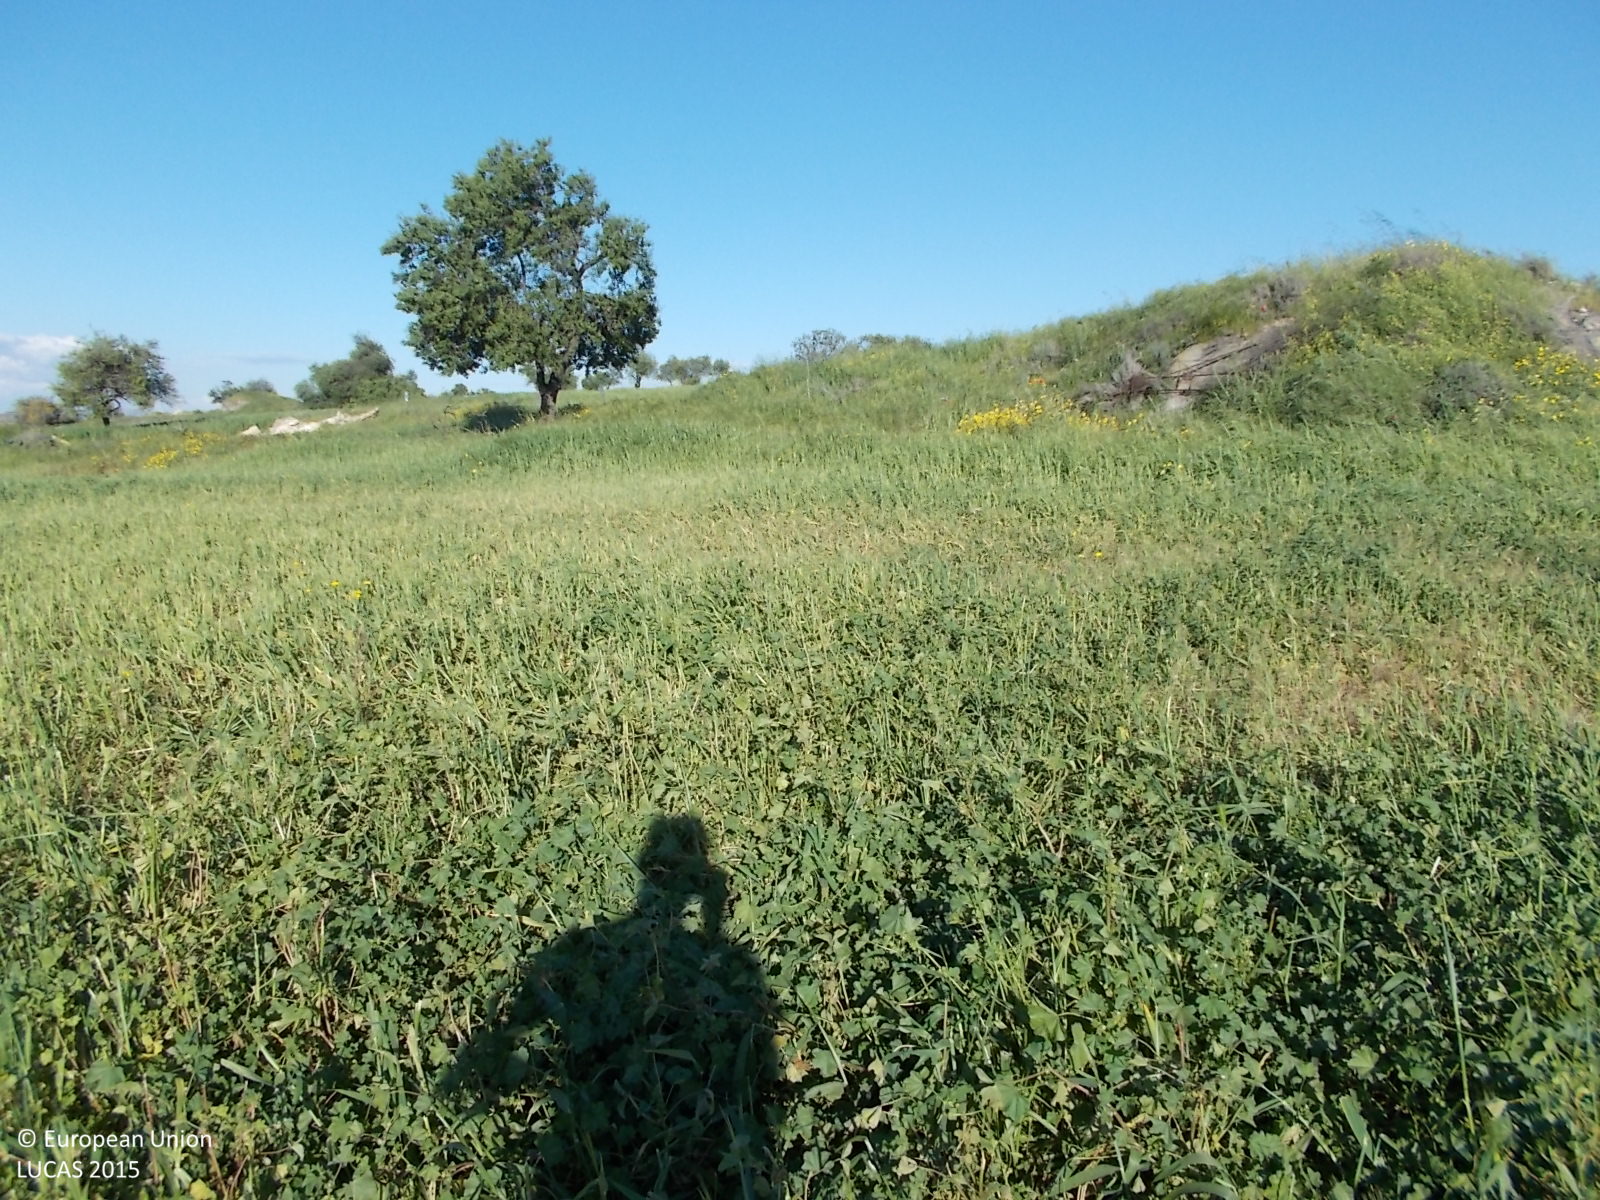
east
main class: Cropland
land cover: Mixed cereals for fodder
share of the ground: > 75 %
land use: Agriculture (excluding fallow land and kitchen gardens)
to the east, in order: Mixed cereals for fodder; Single bushes/trees; Spontaneously vegetated surfaces; Fences; Barley; Single bushes/trees; Barley
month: April
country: CY
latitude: 34.9908
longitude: 33.4730
